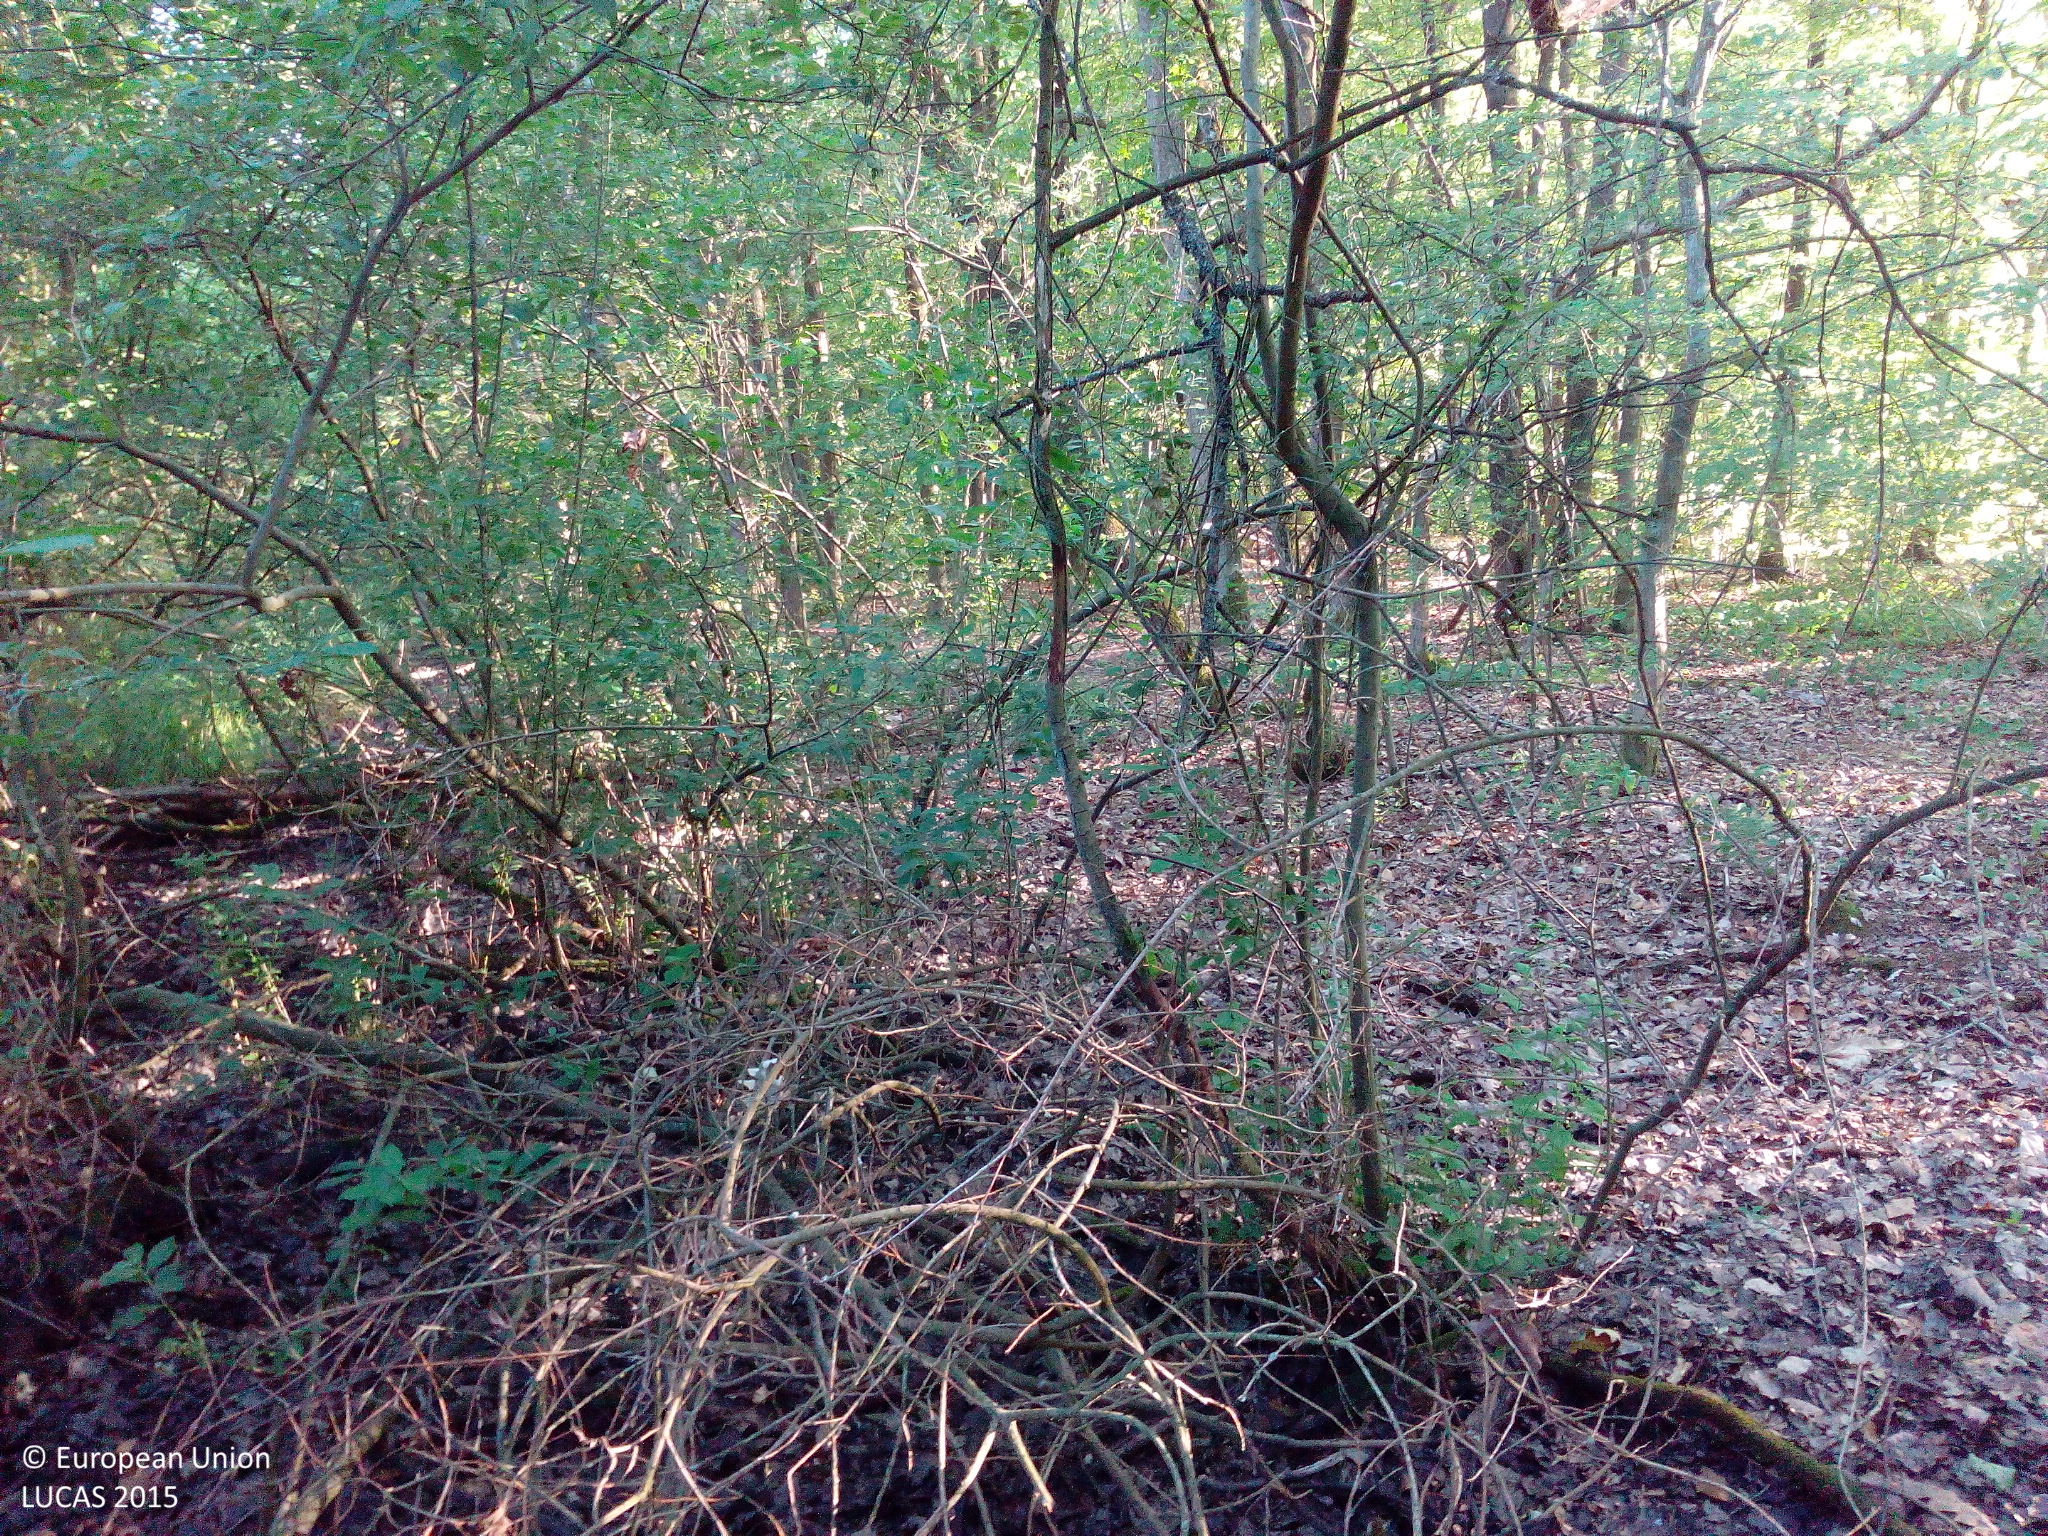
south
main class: Woodland
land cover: Broadleaved woodland
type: mire and swamp forests
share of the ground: > 75 %
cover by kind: broadleaved forest trees 95 %, herbaceous plants 5 %
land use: Semi-natural and natural areas not in use
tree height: > 5 m
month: July
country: DE
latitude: 49.7705
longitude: 9.8473
